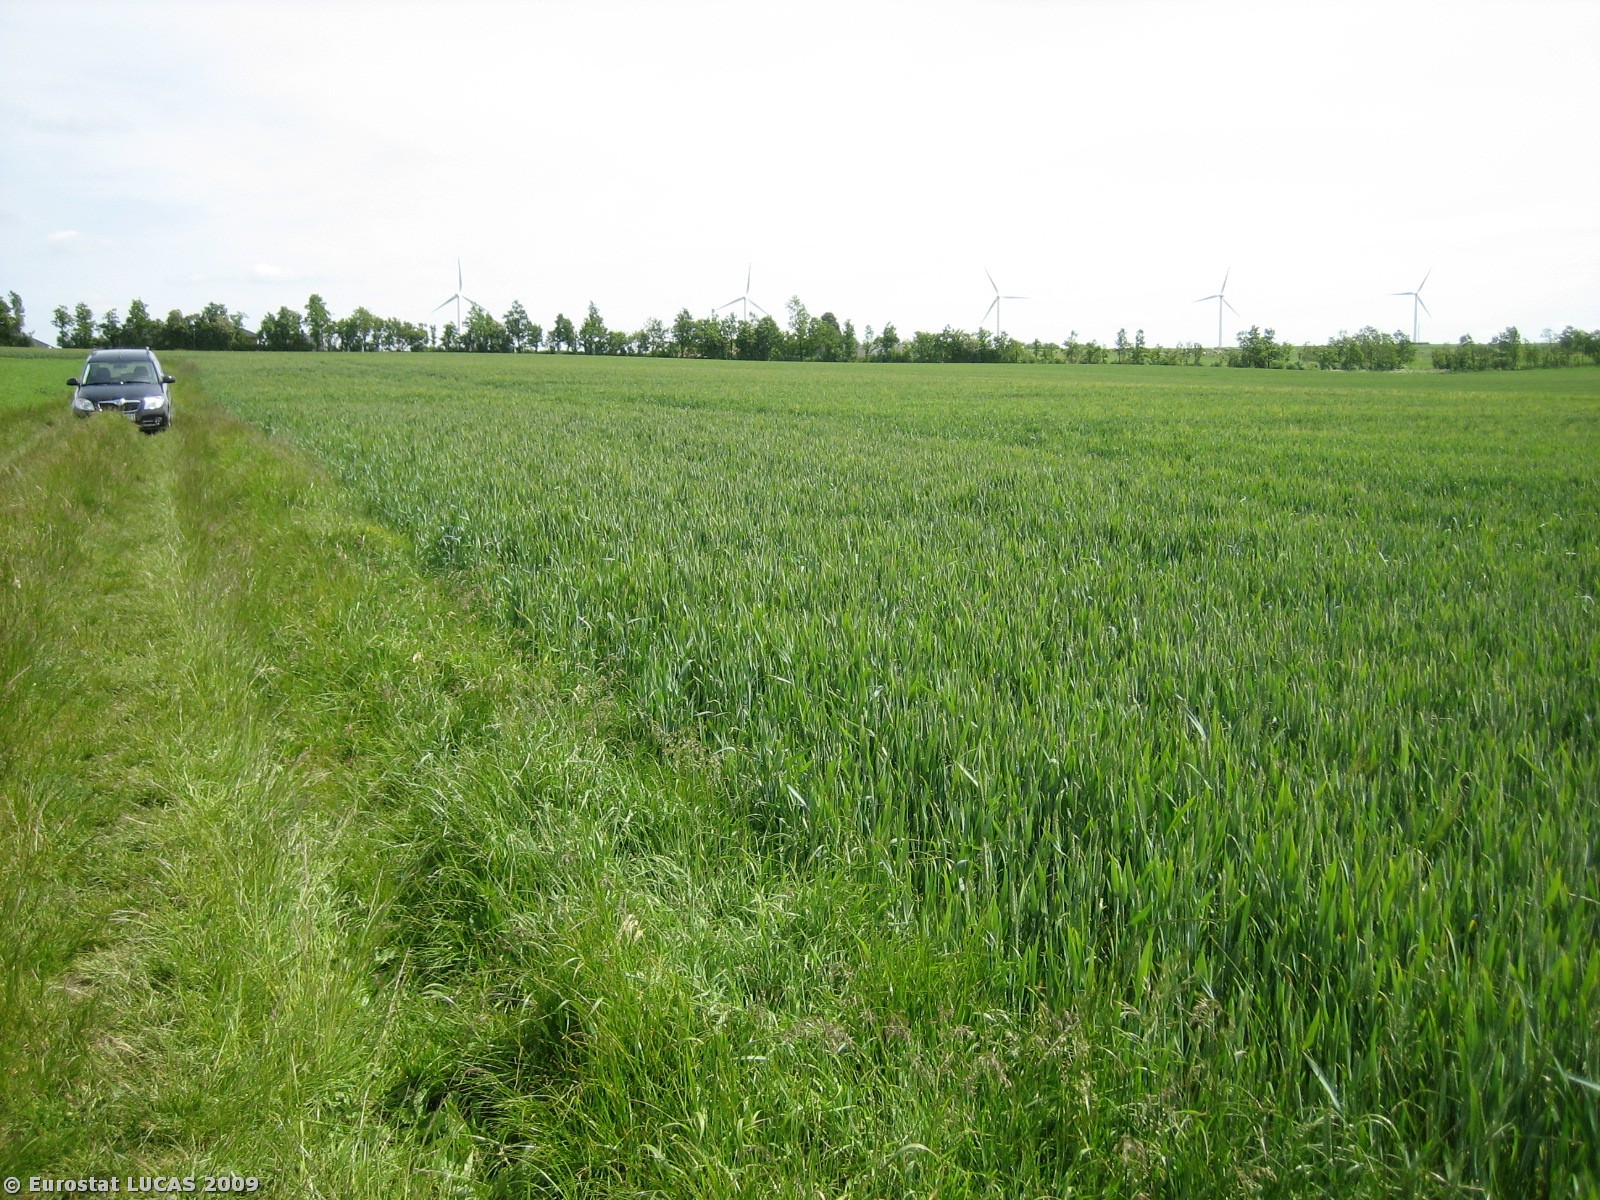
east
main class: Cropland
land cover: Common wheat
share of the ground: > 75 %
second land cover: Barley
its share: < 10 %
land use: Agriculture (excluding fallow land and kitchen gardens)
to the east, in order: Common wheat; Barley
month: June
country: DK
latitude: 56.2954
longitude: 10.2098
